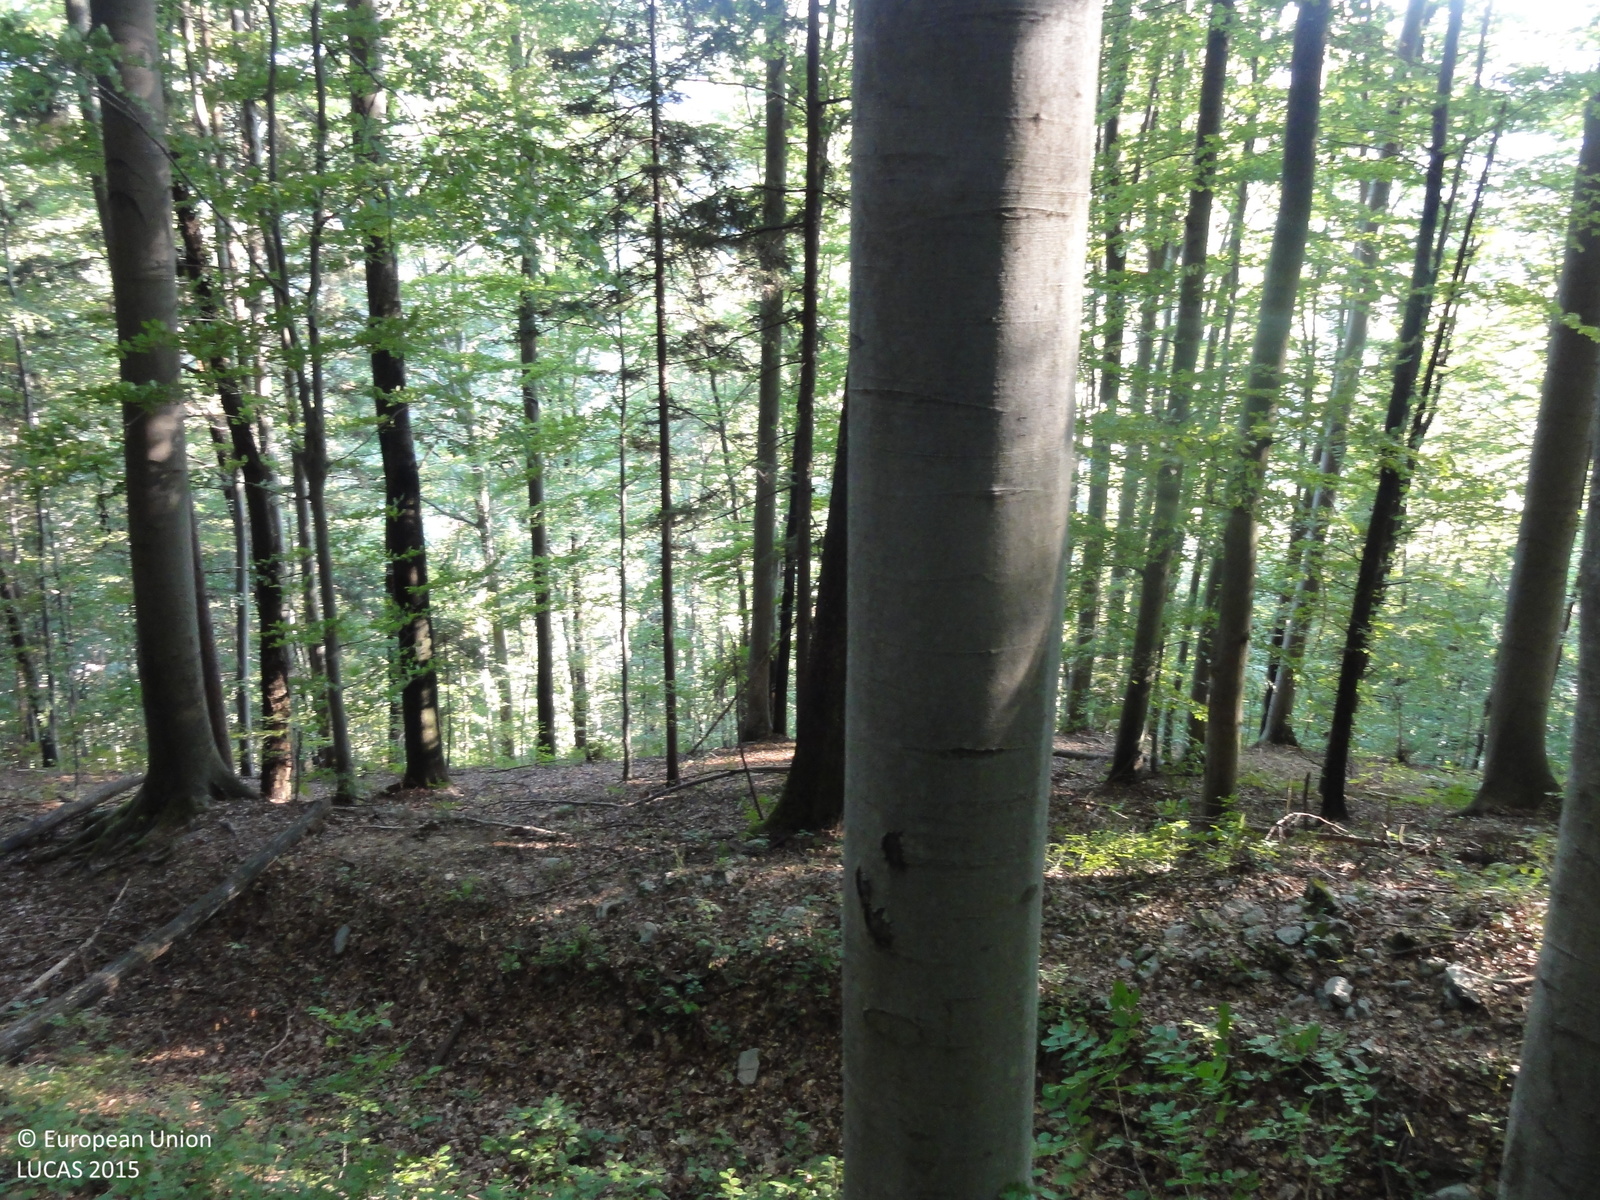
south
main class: Woodland
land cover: Broadleaved woodland
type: beech forest
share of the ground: > 75 %
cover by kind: broadleaved forest trees 95 %, coniferous forest trees 5 %
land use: Forestry
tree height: > 5 m
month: August
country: SI
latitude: 46.0657
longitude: 15.1294
